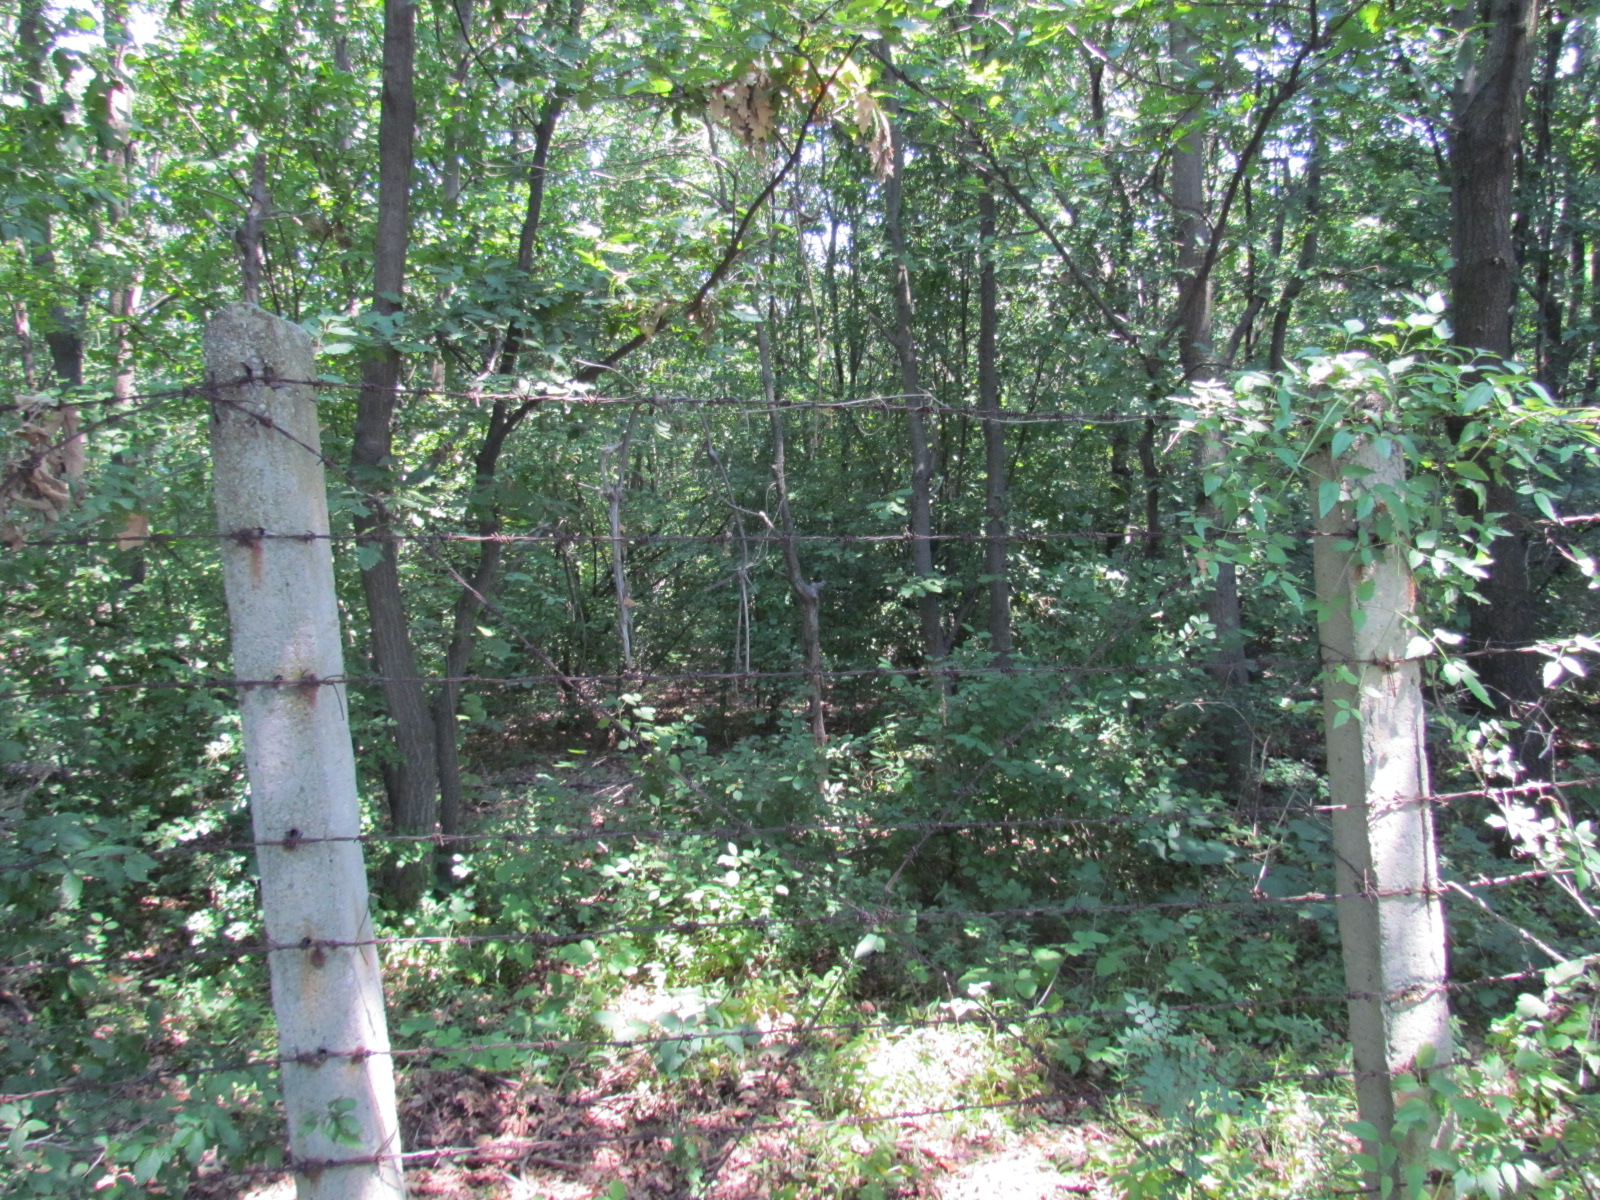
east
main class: Woodland
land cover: Broadleaved woodland
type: acidophilous oak and oak-birch forest
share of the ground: > 75 %
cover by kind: broadleaved forest trees 95 %, shrubs 5 %
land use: Forestry
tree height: > 5 m
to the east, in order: Broadleaved woodland
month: July
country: BG
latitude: 42.7797
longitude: 27.8929
